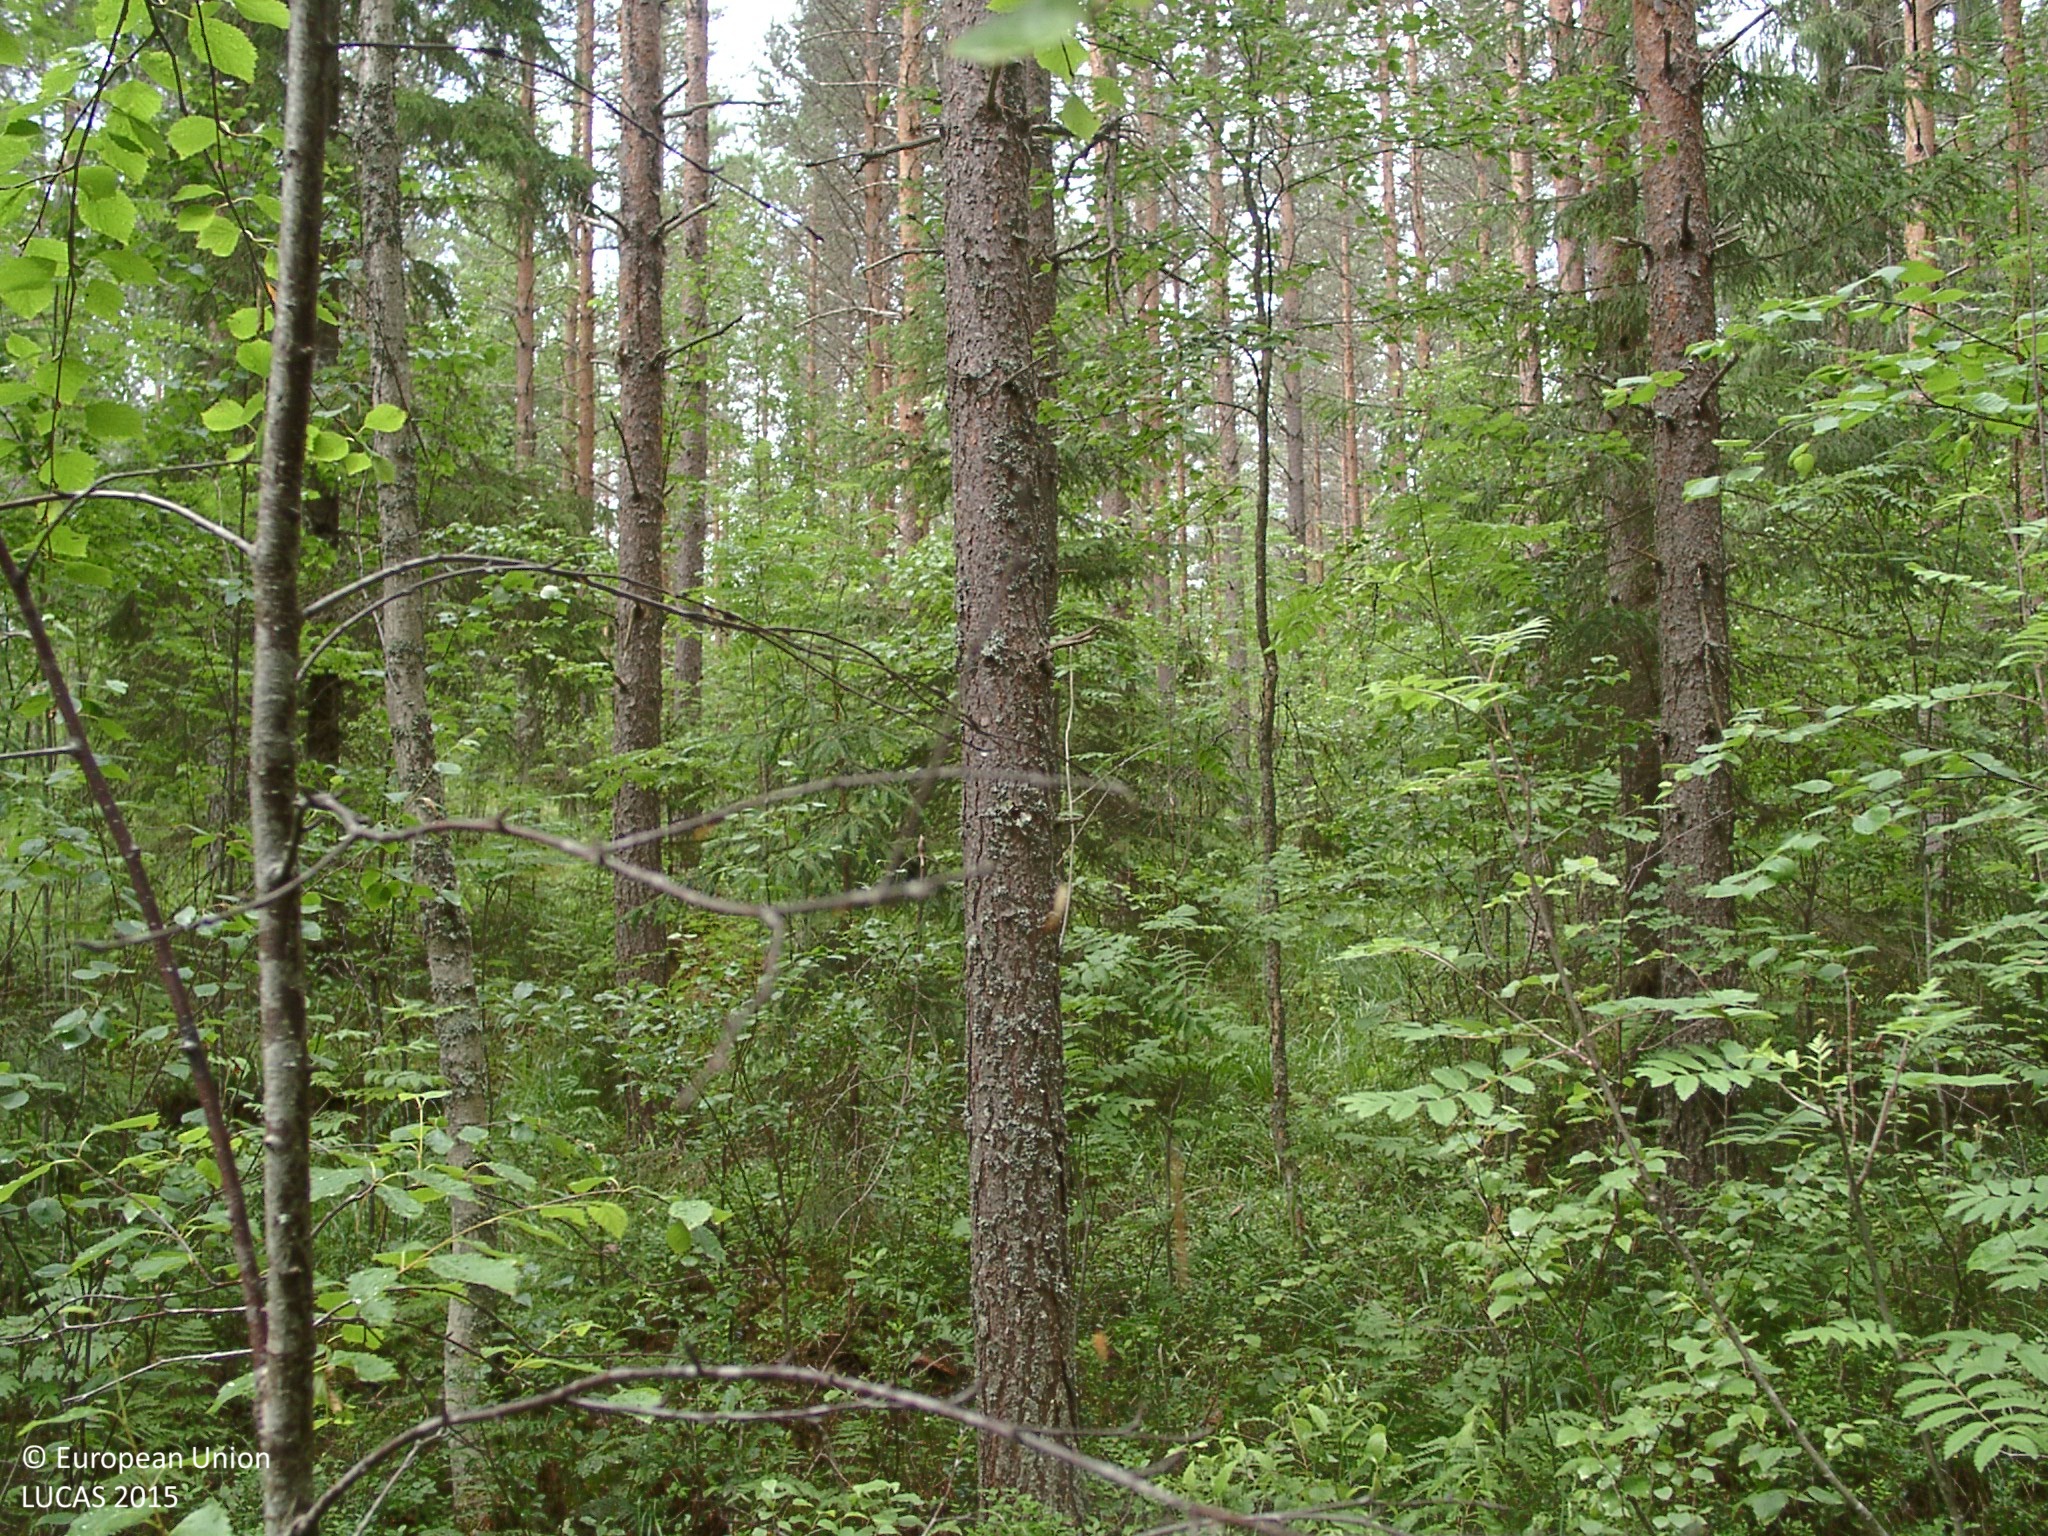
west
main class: Woodland
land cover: Other mixed woodland
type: boreal forest
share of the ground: 50 - 75 %
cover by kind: coniferous forest trees 45 %, broadleaved forest trees 25 %, shrubs 20 %, lichens and mosses 10 %
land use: Forestry
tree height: > 5 m
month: July
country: FI
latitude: 61.6456
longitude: 24.8847
